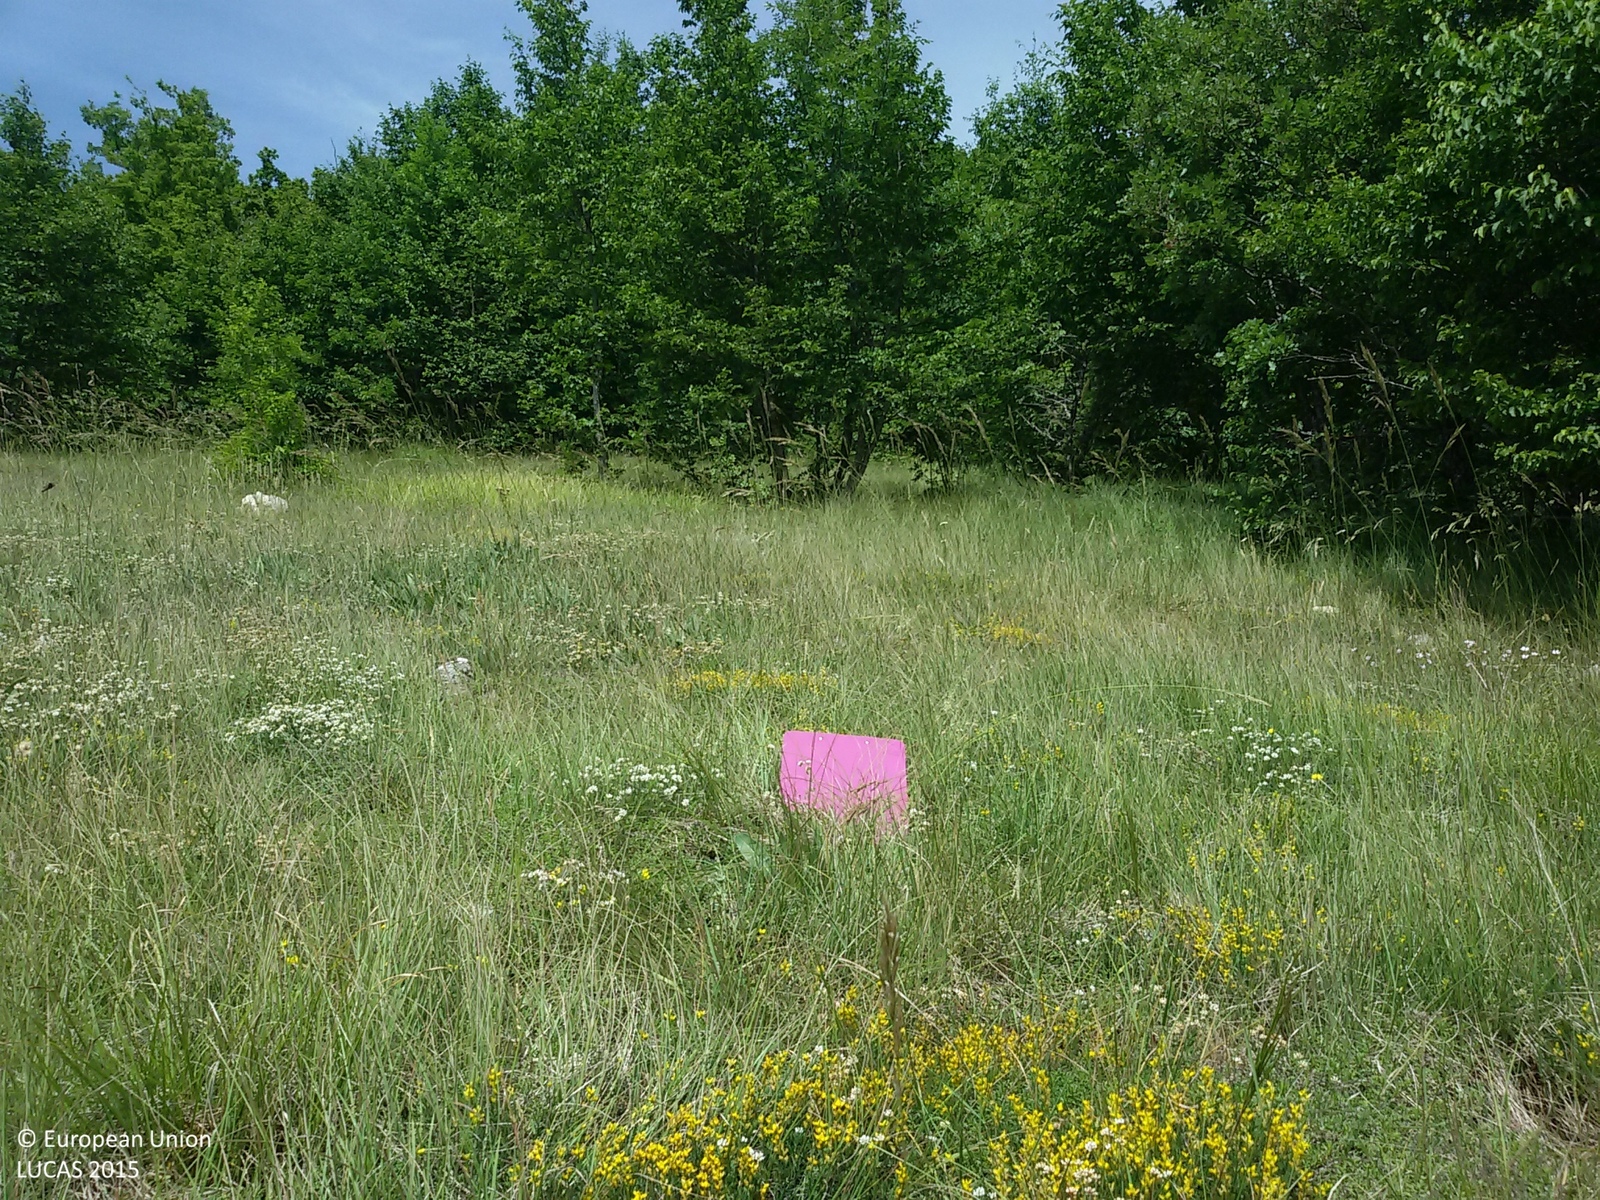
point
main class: Woodland
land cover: Broadleaved woodland
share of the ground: 10 - 25 %
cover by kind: herbaceous plants 55 %, broadleaved forest trees 15 %, unconsolidated bare surface 15 %, shrubs 10 %, consolidated bare surface 5 %
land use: Semi-natural and natural areas not in use
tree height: < 5 m
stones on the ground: < 10 %
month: June
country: HR
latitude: 44.5776
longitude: 15.6230
